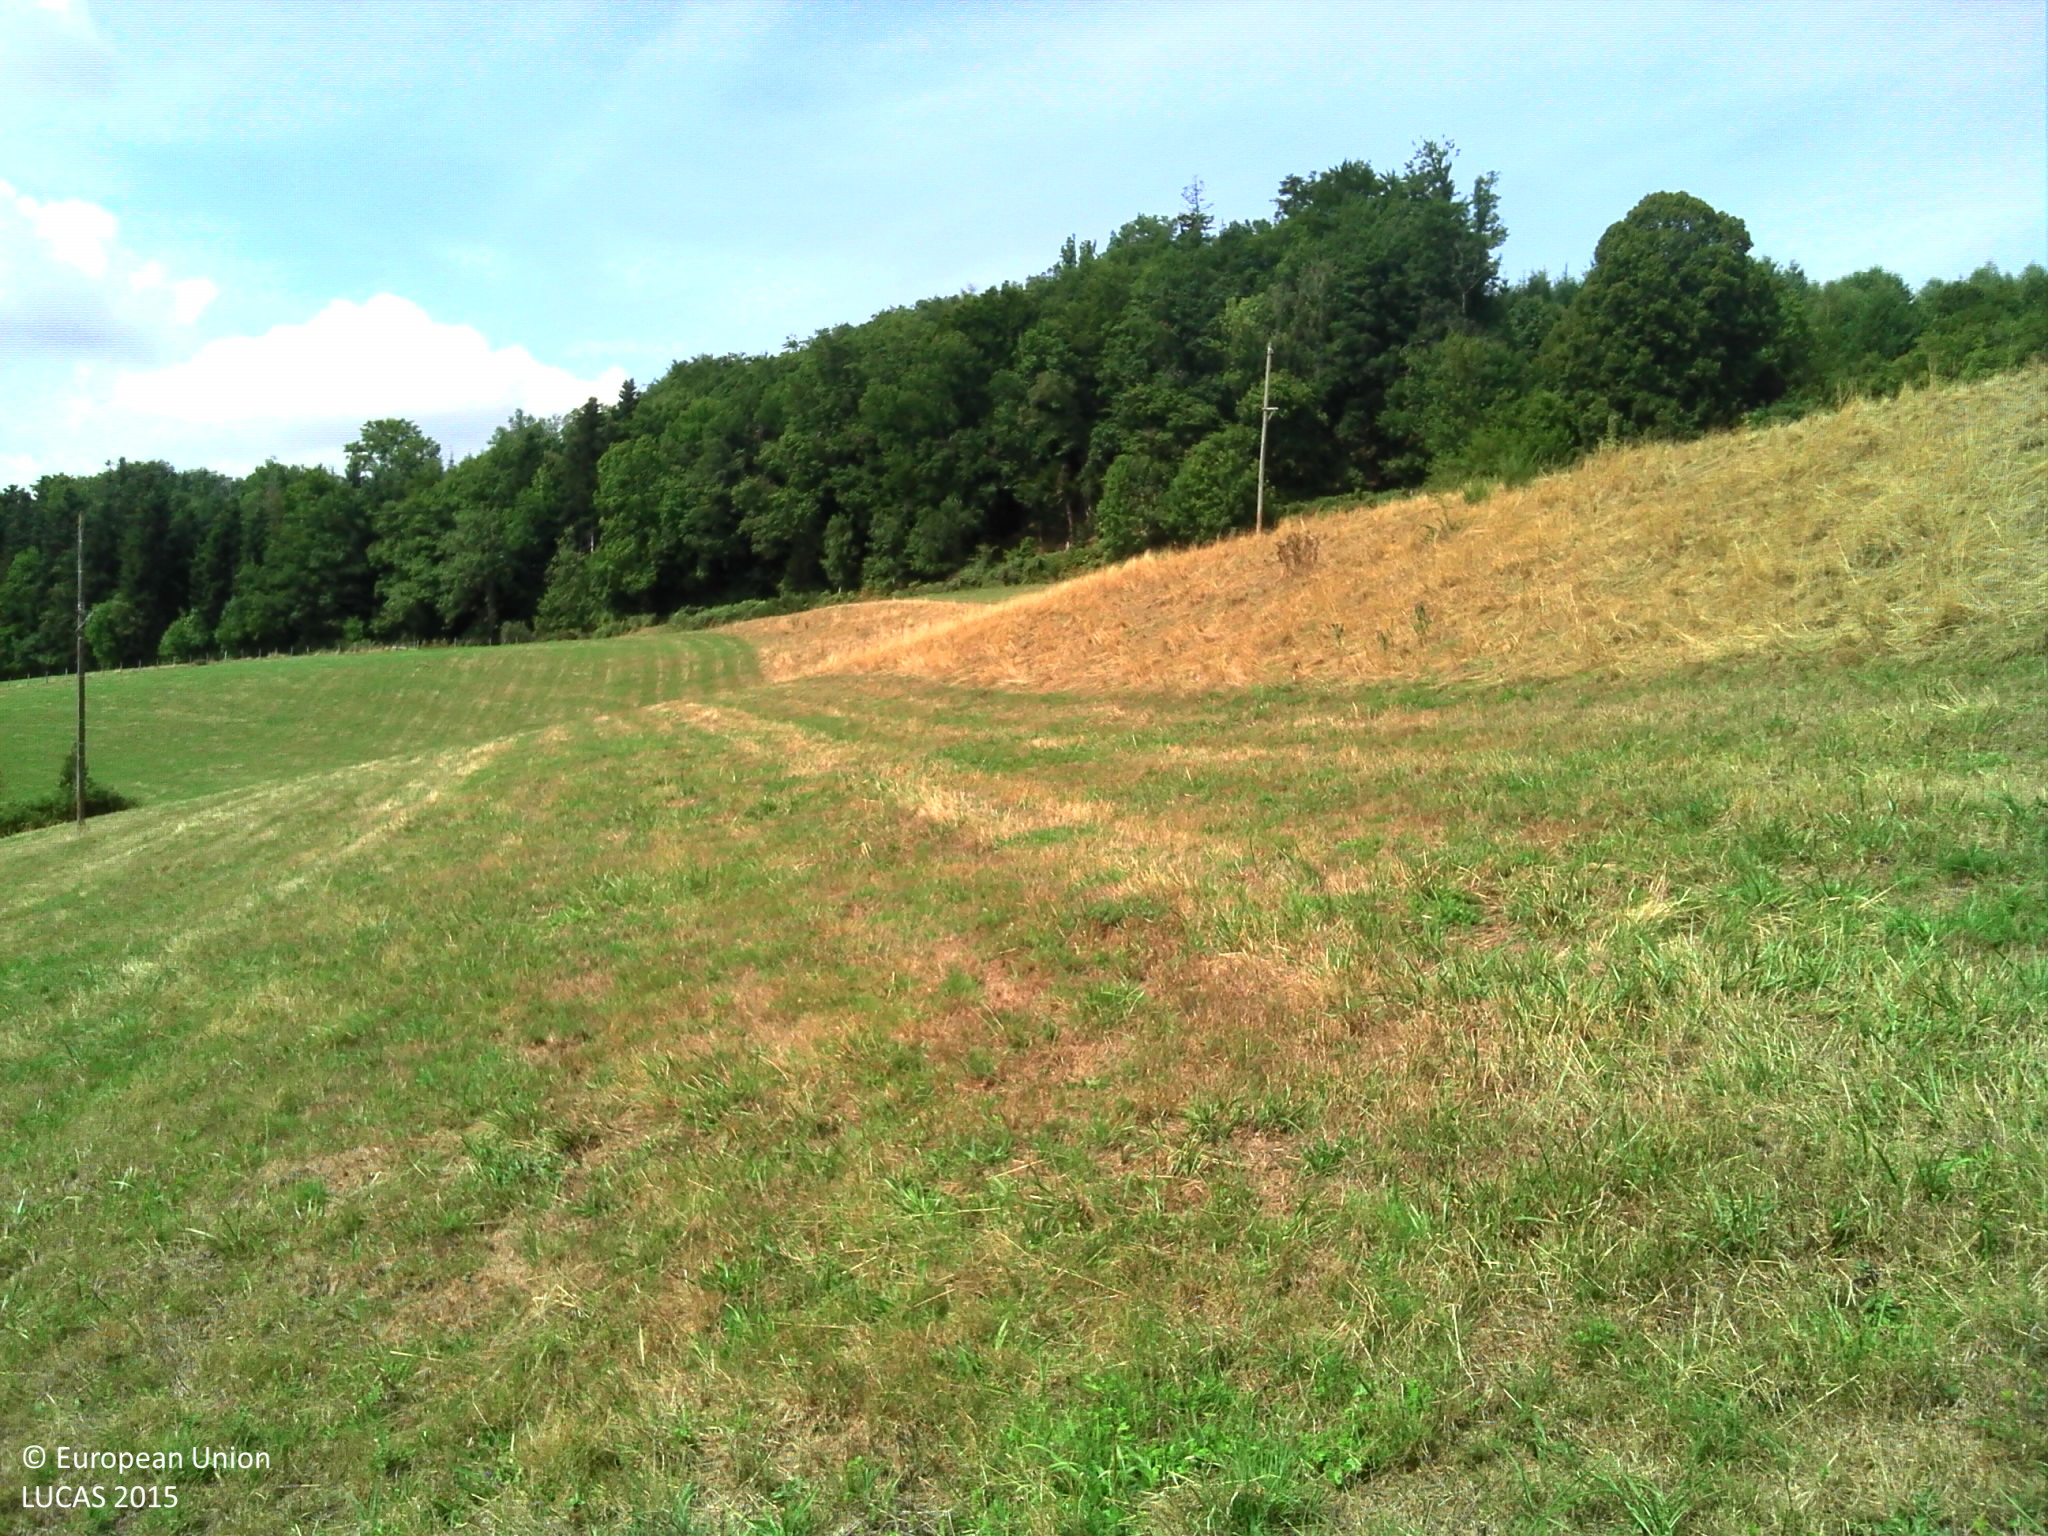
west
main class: Grassland
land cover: Grassland without tree/shrub cover
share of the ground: > 75 %
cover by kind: herbaceous plants 100 %
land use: Agriculture (excluding fallow land and kitchen gardens)
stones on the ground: < 10 %
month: August
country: FR
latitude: 46.1735
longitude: 4.4971
